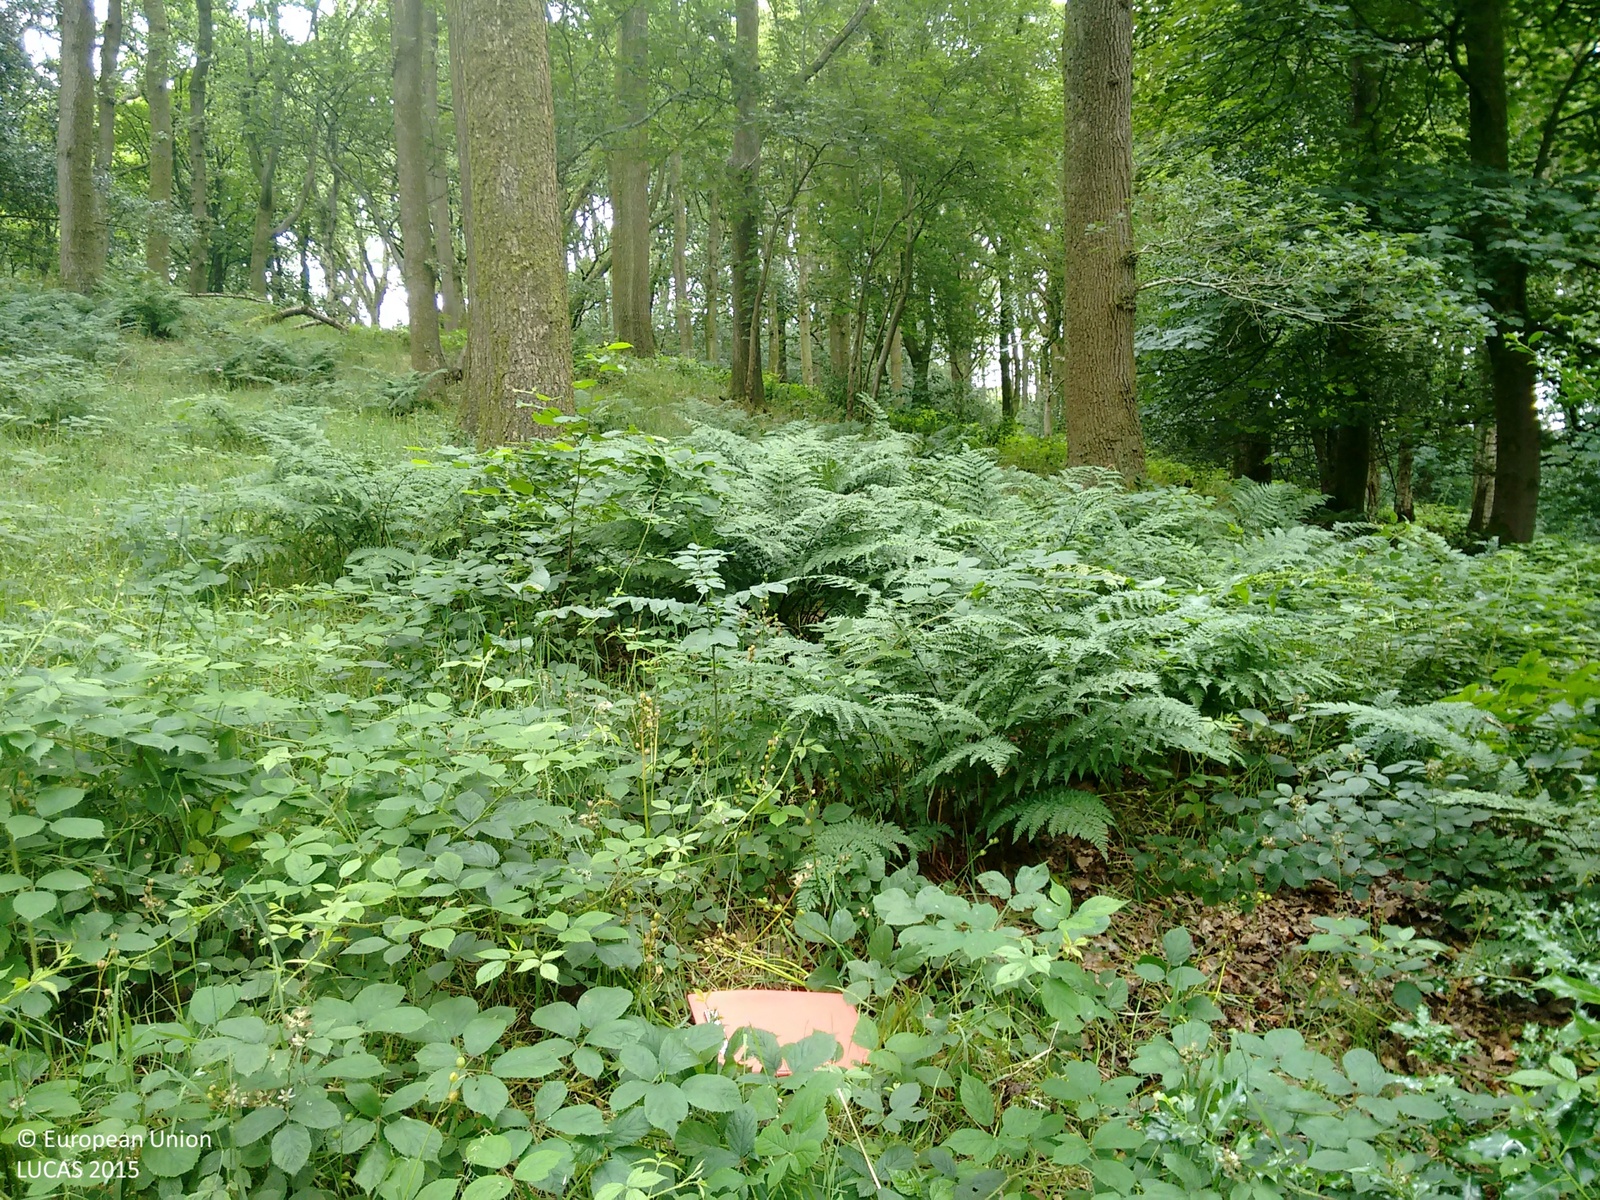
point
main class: Woodland
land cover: Broadleaved woodland
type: mesophytic deciduous forest
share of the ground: > 75 %
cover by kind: broadleaved forest trees 100 %
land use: Agriculture (excluding fallow land and kitchen gardens)
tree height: > 5 m
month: August
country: GB
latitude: 54.2772
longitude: -2.7073
